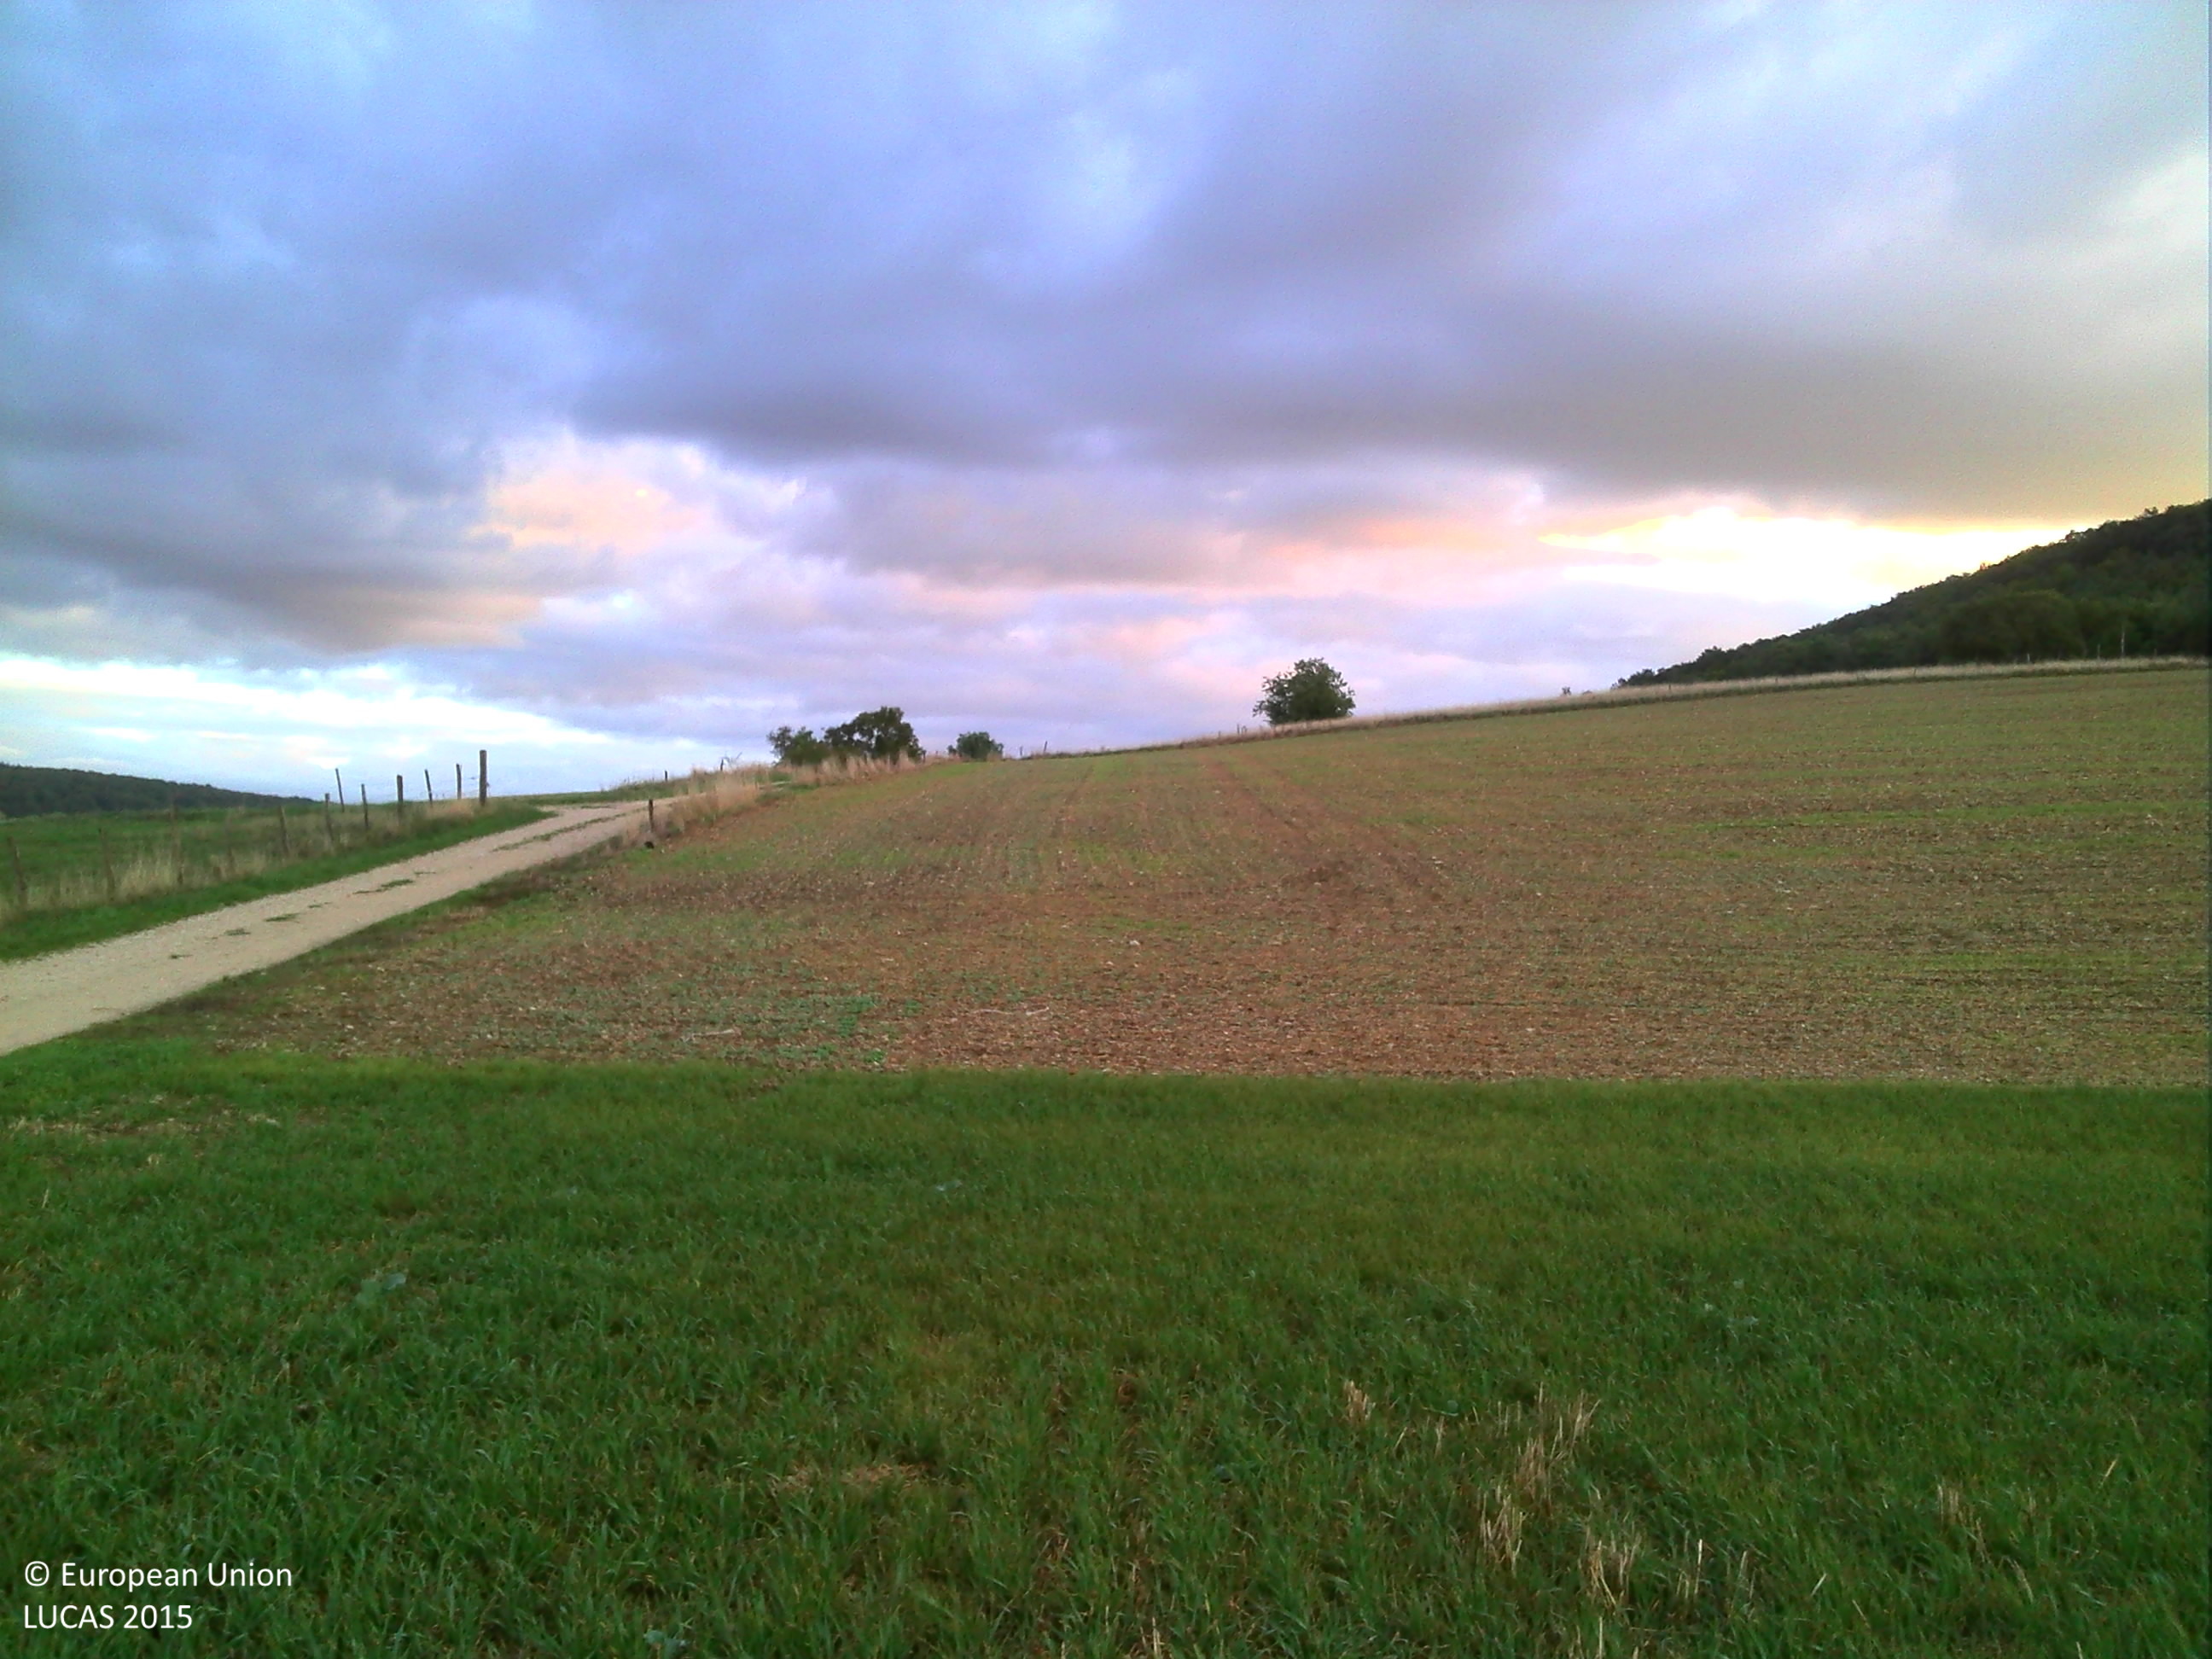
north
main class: Cropland
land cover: Barley
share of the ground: > 75 %
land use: Agriculture (excluding fallow land and kitchen gardens)
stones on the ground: 25 - 50 %
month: September
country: FR
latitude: 48.1189
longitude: 4.7998
